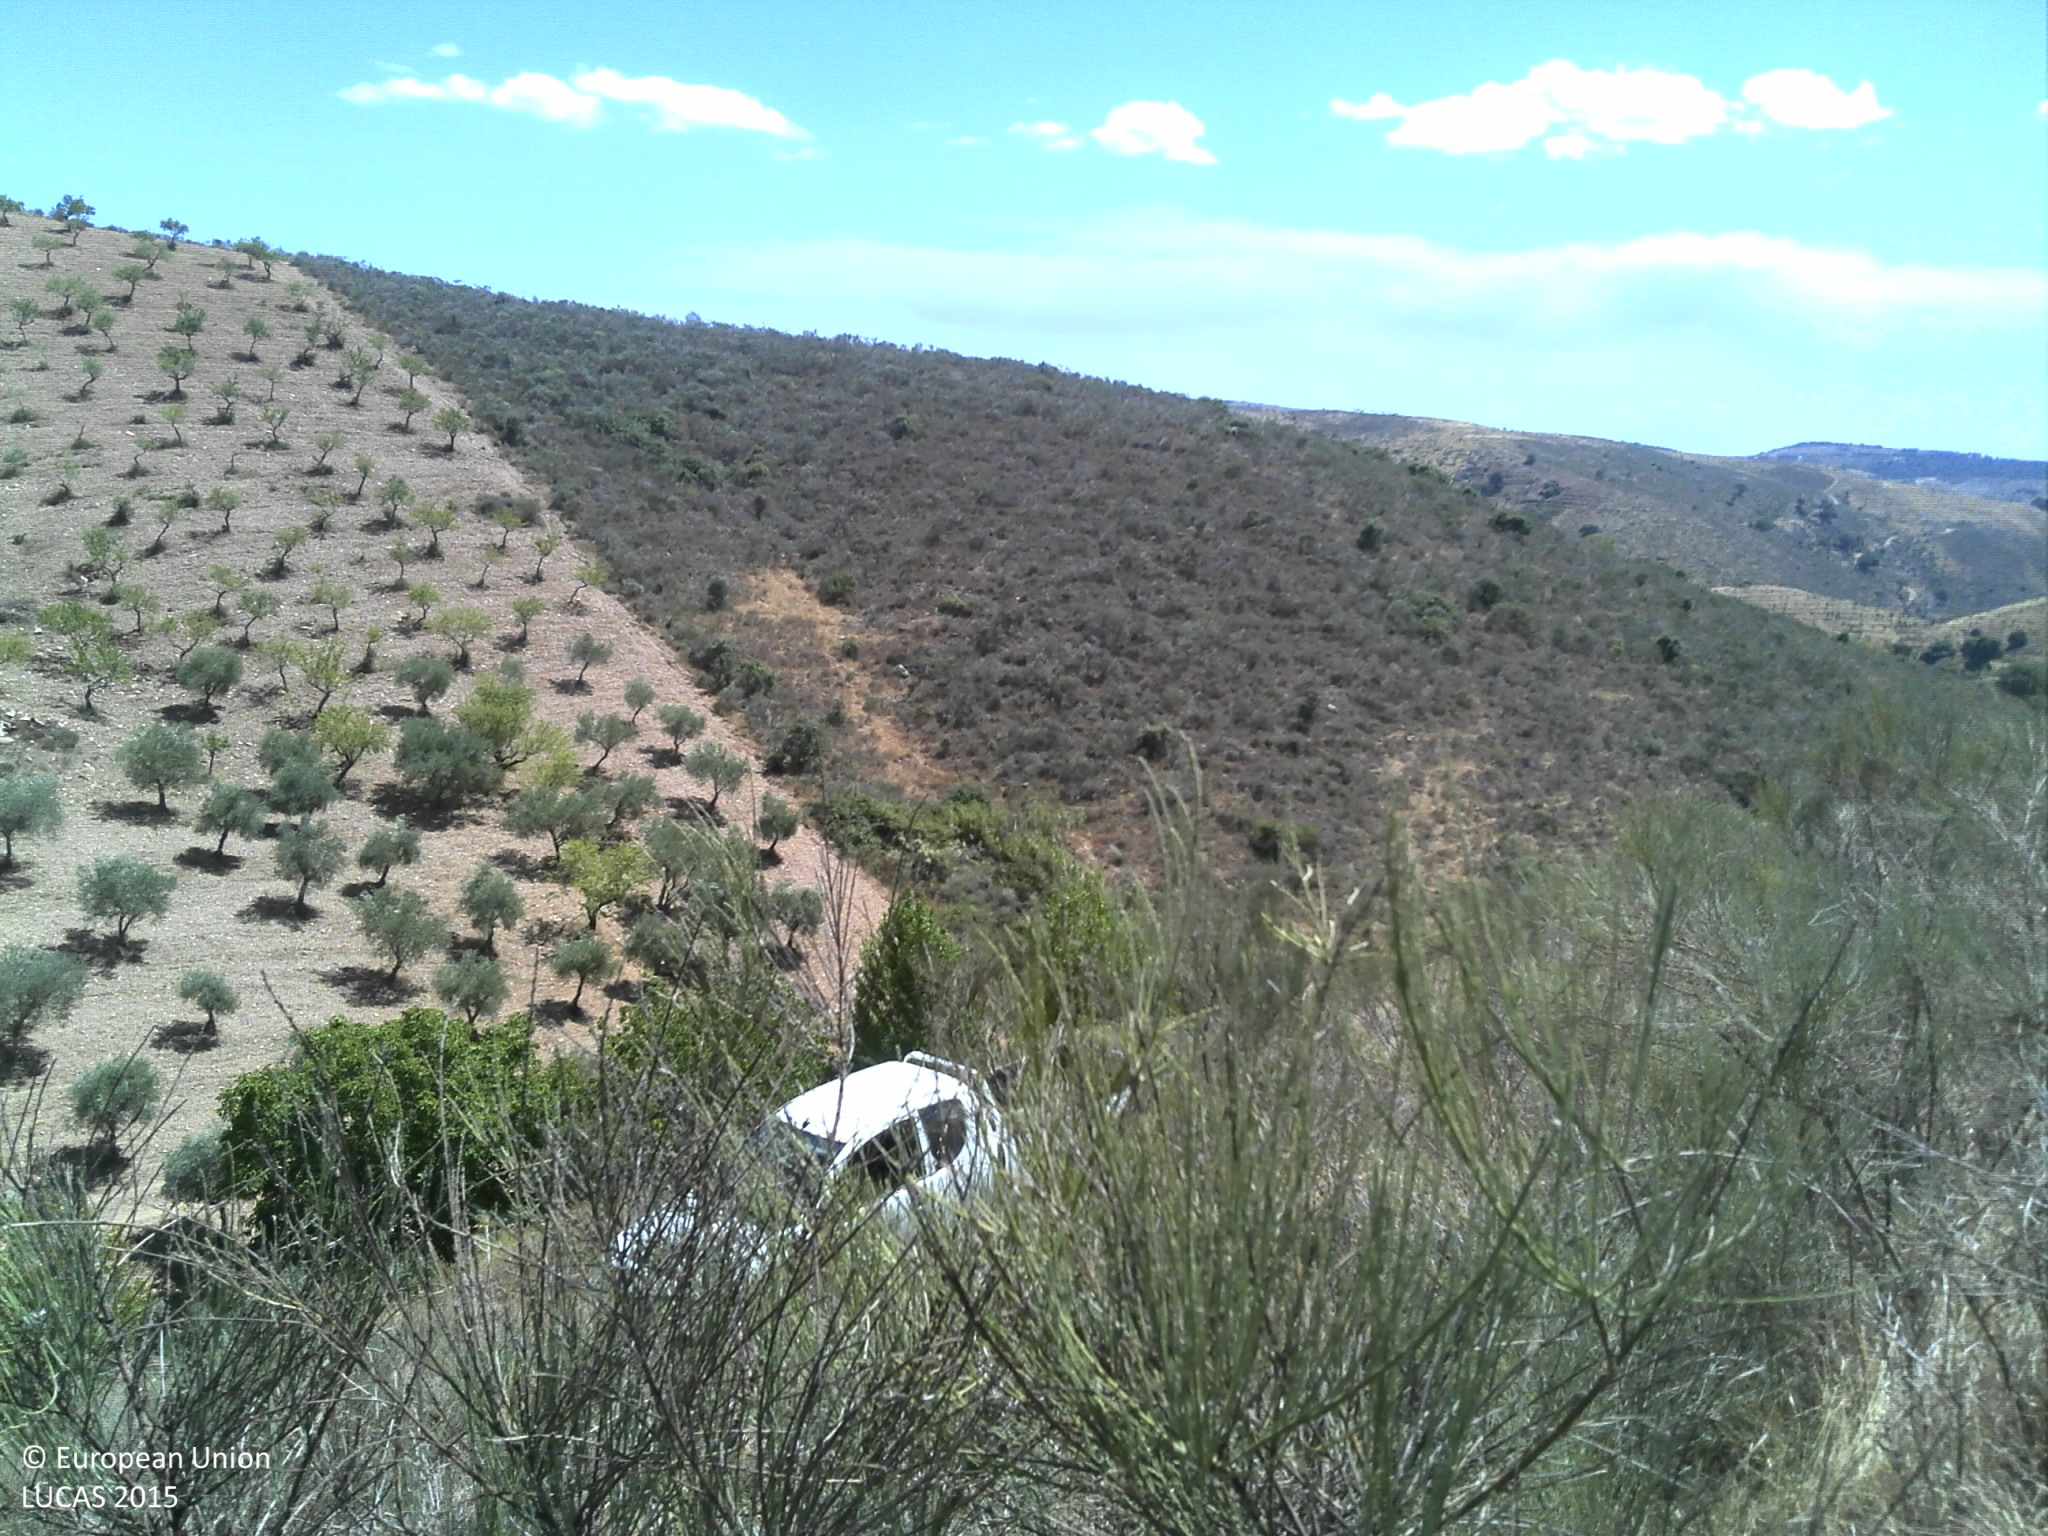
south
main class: Shrubland
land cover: Shrubland with sparse tree cover
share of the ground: > 75 %
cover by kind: shrubs 95 %, broadleaved forest trees 5 %
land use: Semi-natural and natural areas not in use
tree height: < 5 m
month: July
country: PT
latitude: 41.3517
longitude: -7.0008
